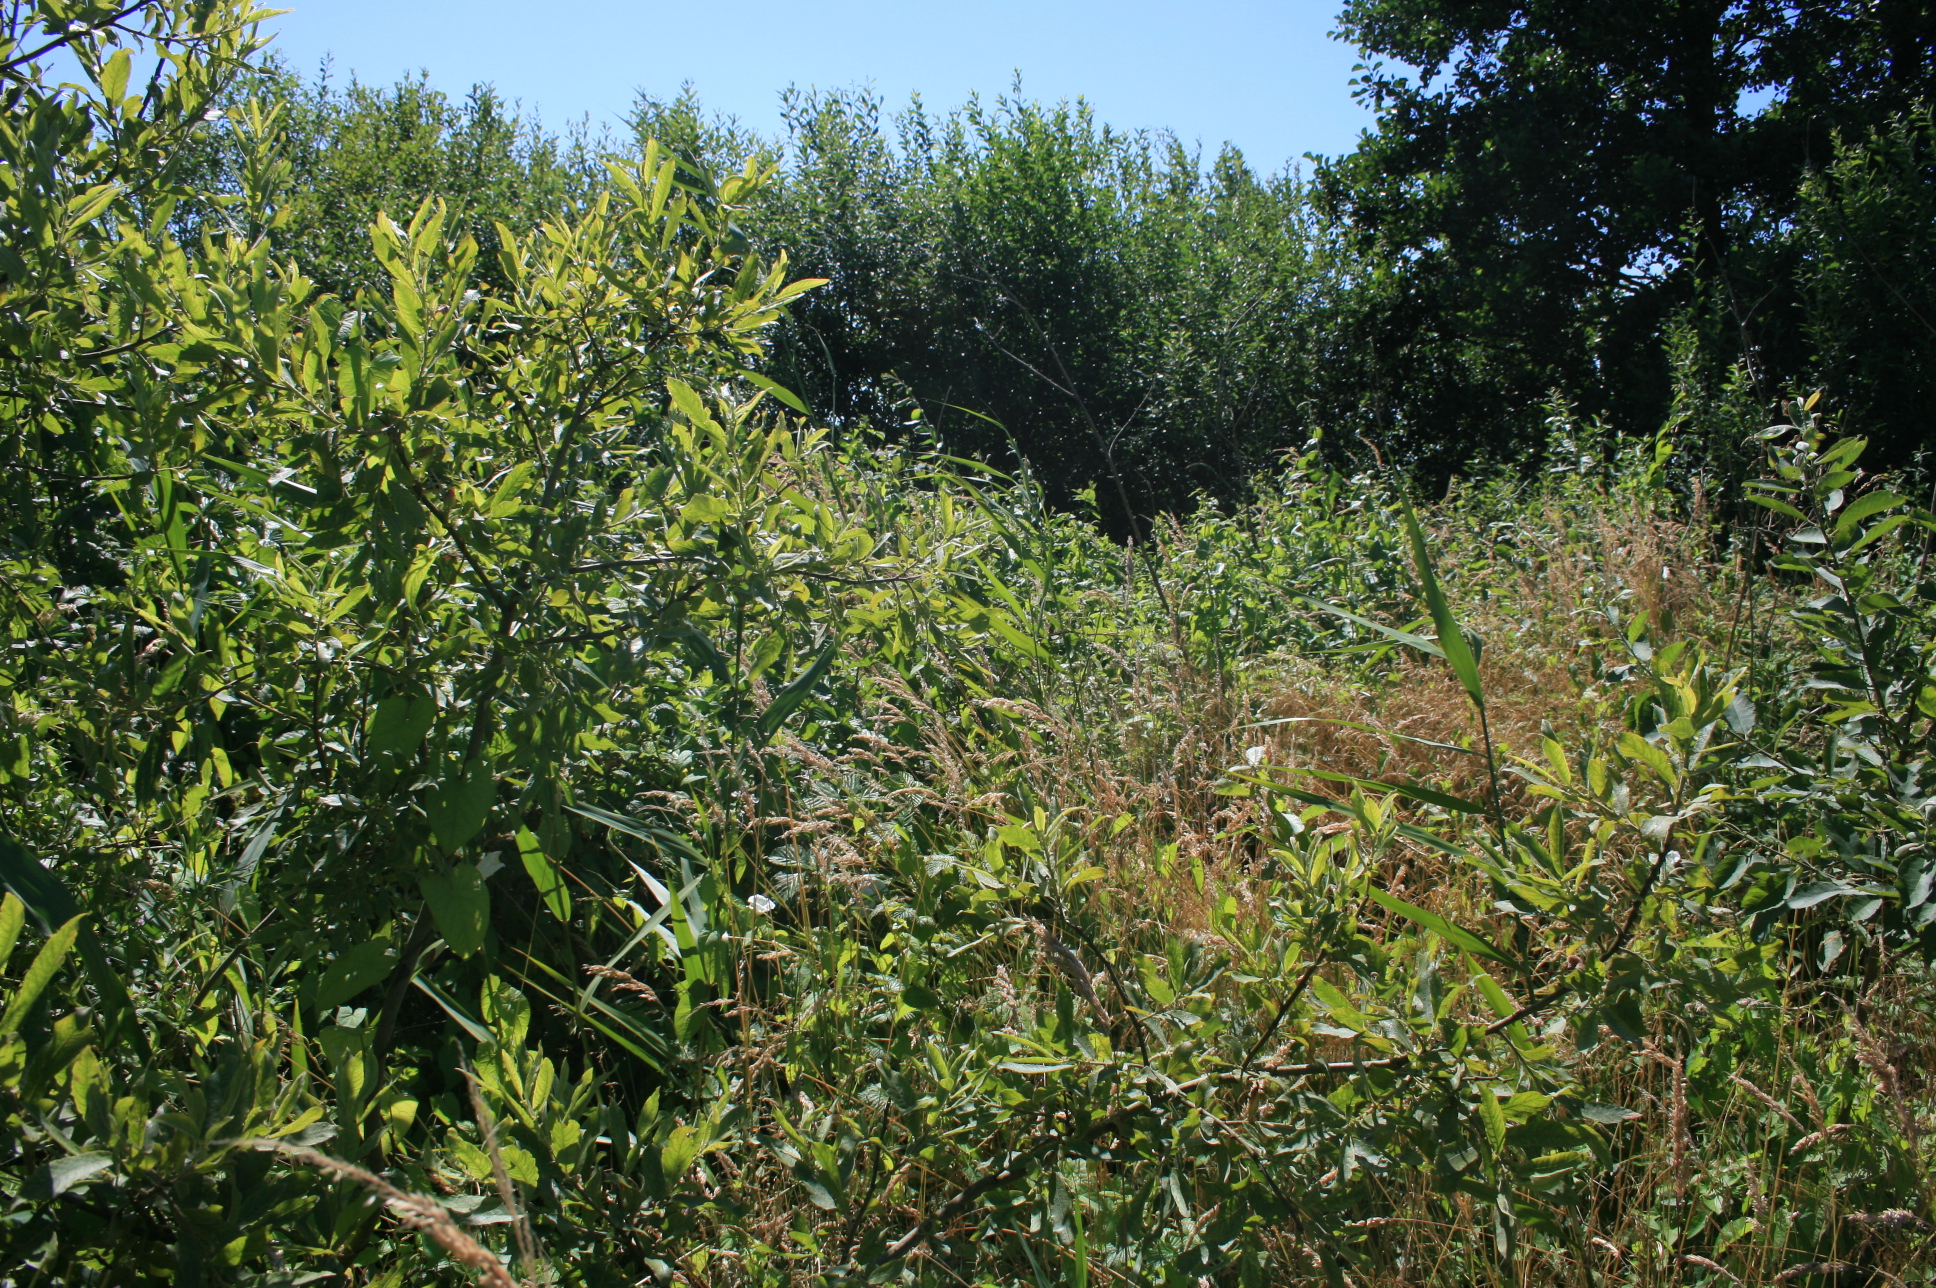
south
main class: Shrubland
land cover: Shrubland with sparse tree cover
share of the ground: 50 - 75 %
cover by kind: herbaceous plants 65 %, shrubs 30 %, broadleaved forest trees 5 %
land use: Semi-natural and natural areas not in use
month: July
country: LT
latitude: 55.4725
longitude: 21.2587
